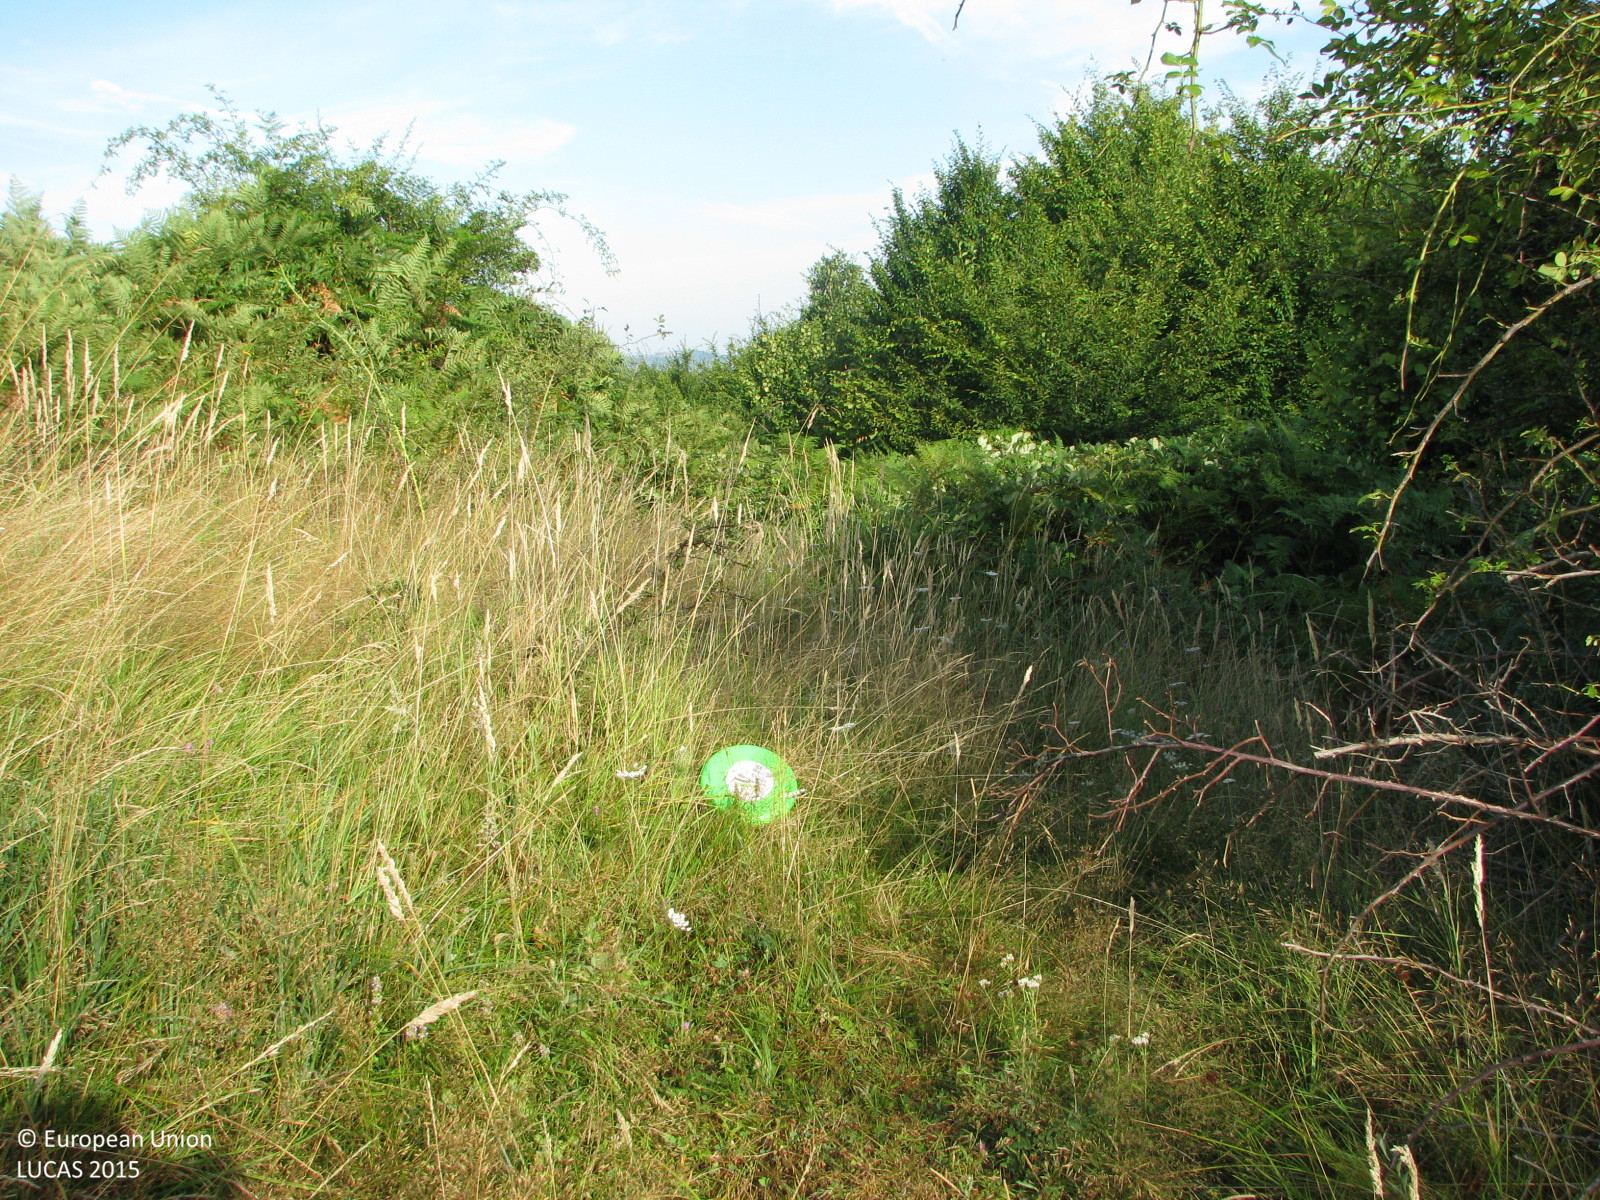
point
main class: Shrubland
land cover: Shrubland without tree cover
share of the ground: 25 - 50 %
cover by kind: herbaceous plants 55 %, shrubs 45 %
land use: Forestry
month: August
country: BG
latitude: 42.8851
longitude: 26.1907
